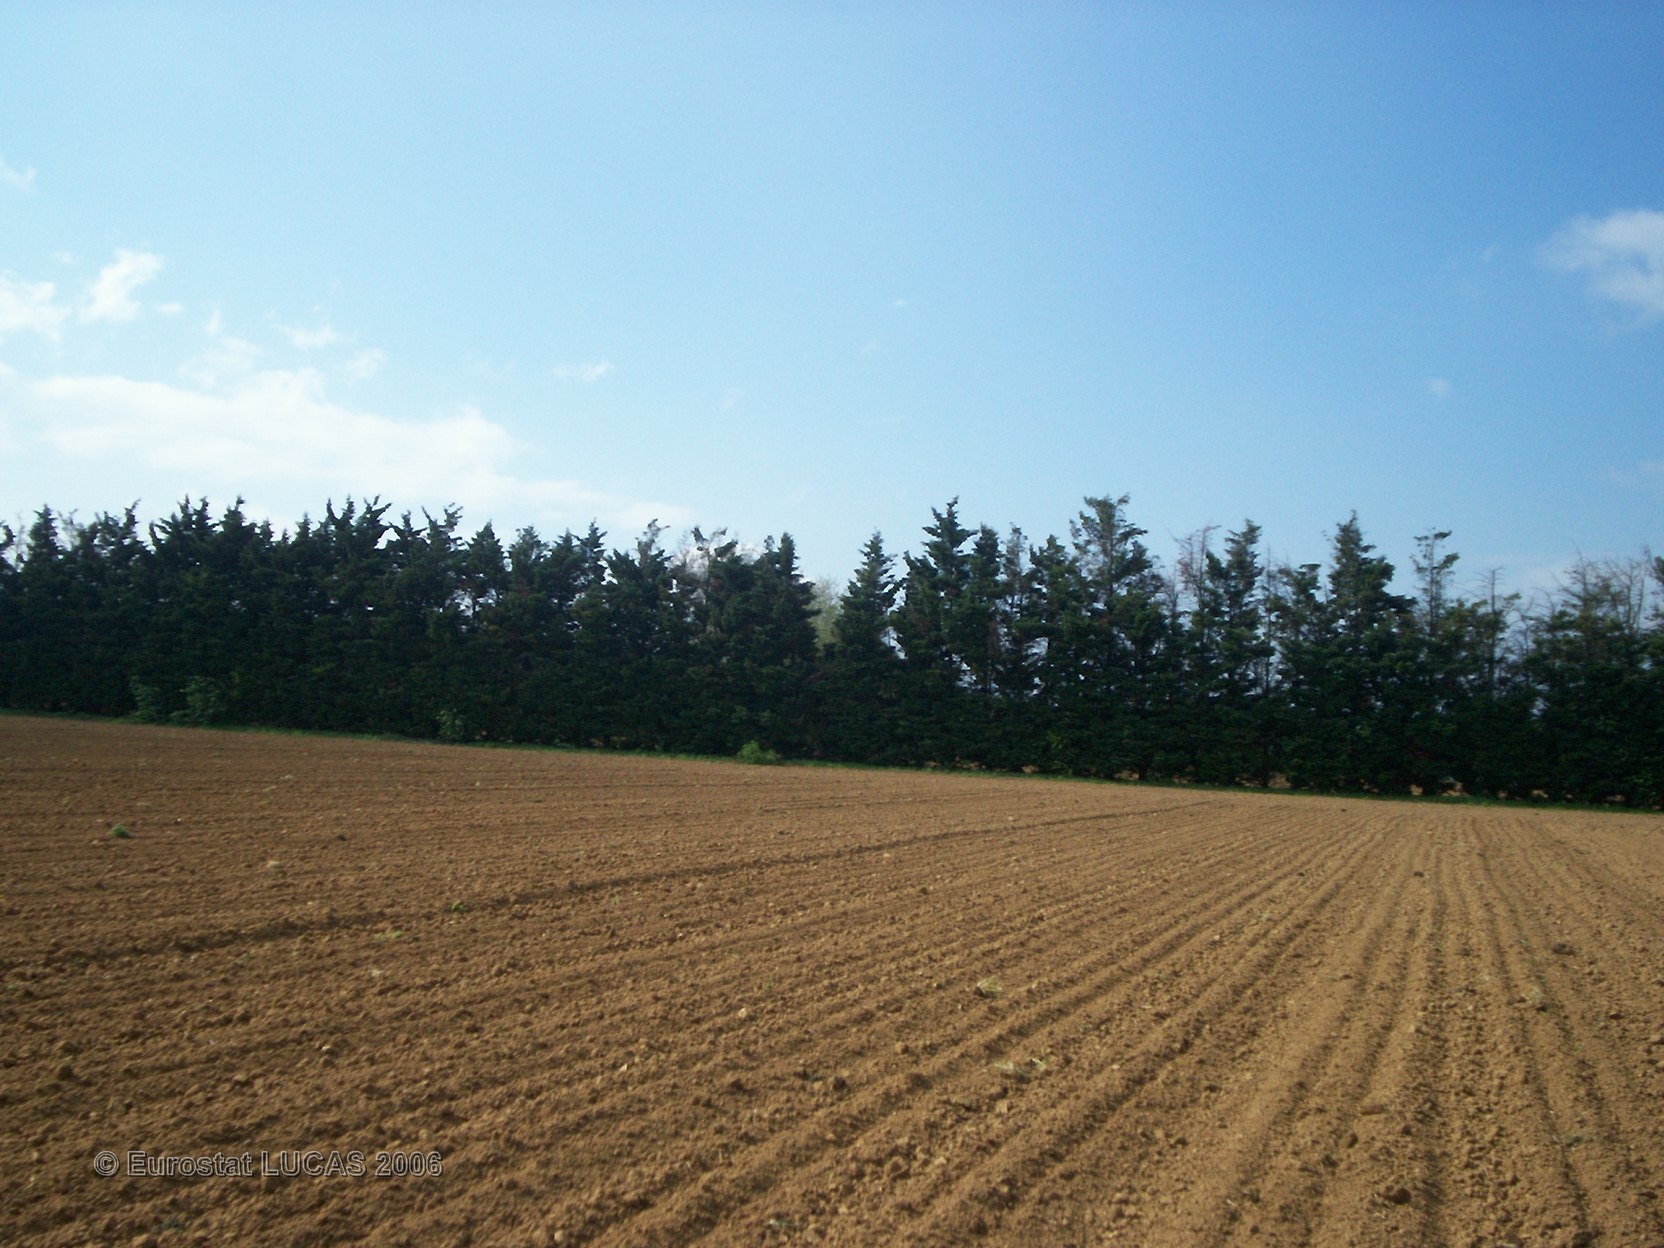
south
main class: Cropland
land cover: Maize
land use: Agriculture (excluding fallow land and kitchen gardens)
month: June
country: FR
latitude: 44.8026
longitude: 4.8859
